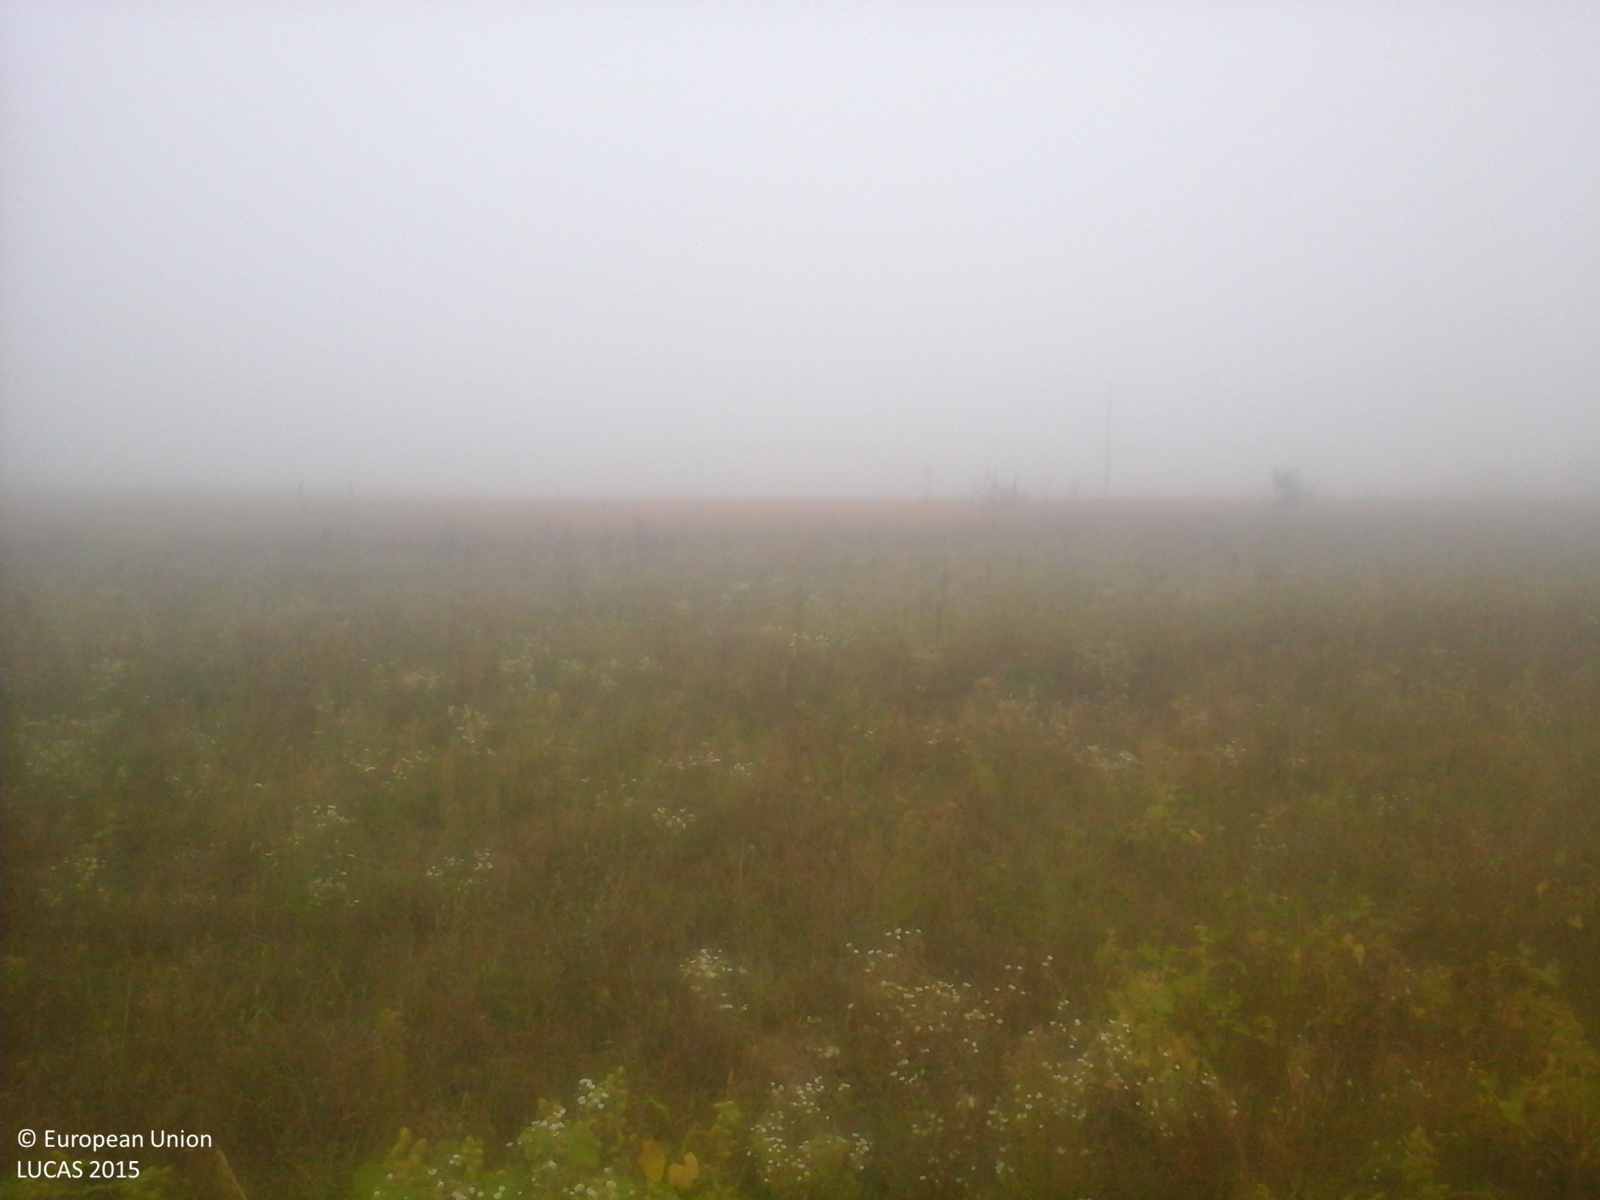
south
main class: Cropland
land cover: Maize
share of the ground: > 75 %
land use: Agriculture (excluding fallow land and kitchen gardens)
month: September
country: RO
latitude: 45.5852
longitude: 21.9713
